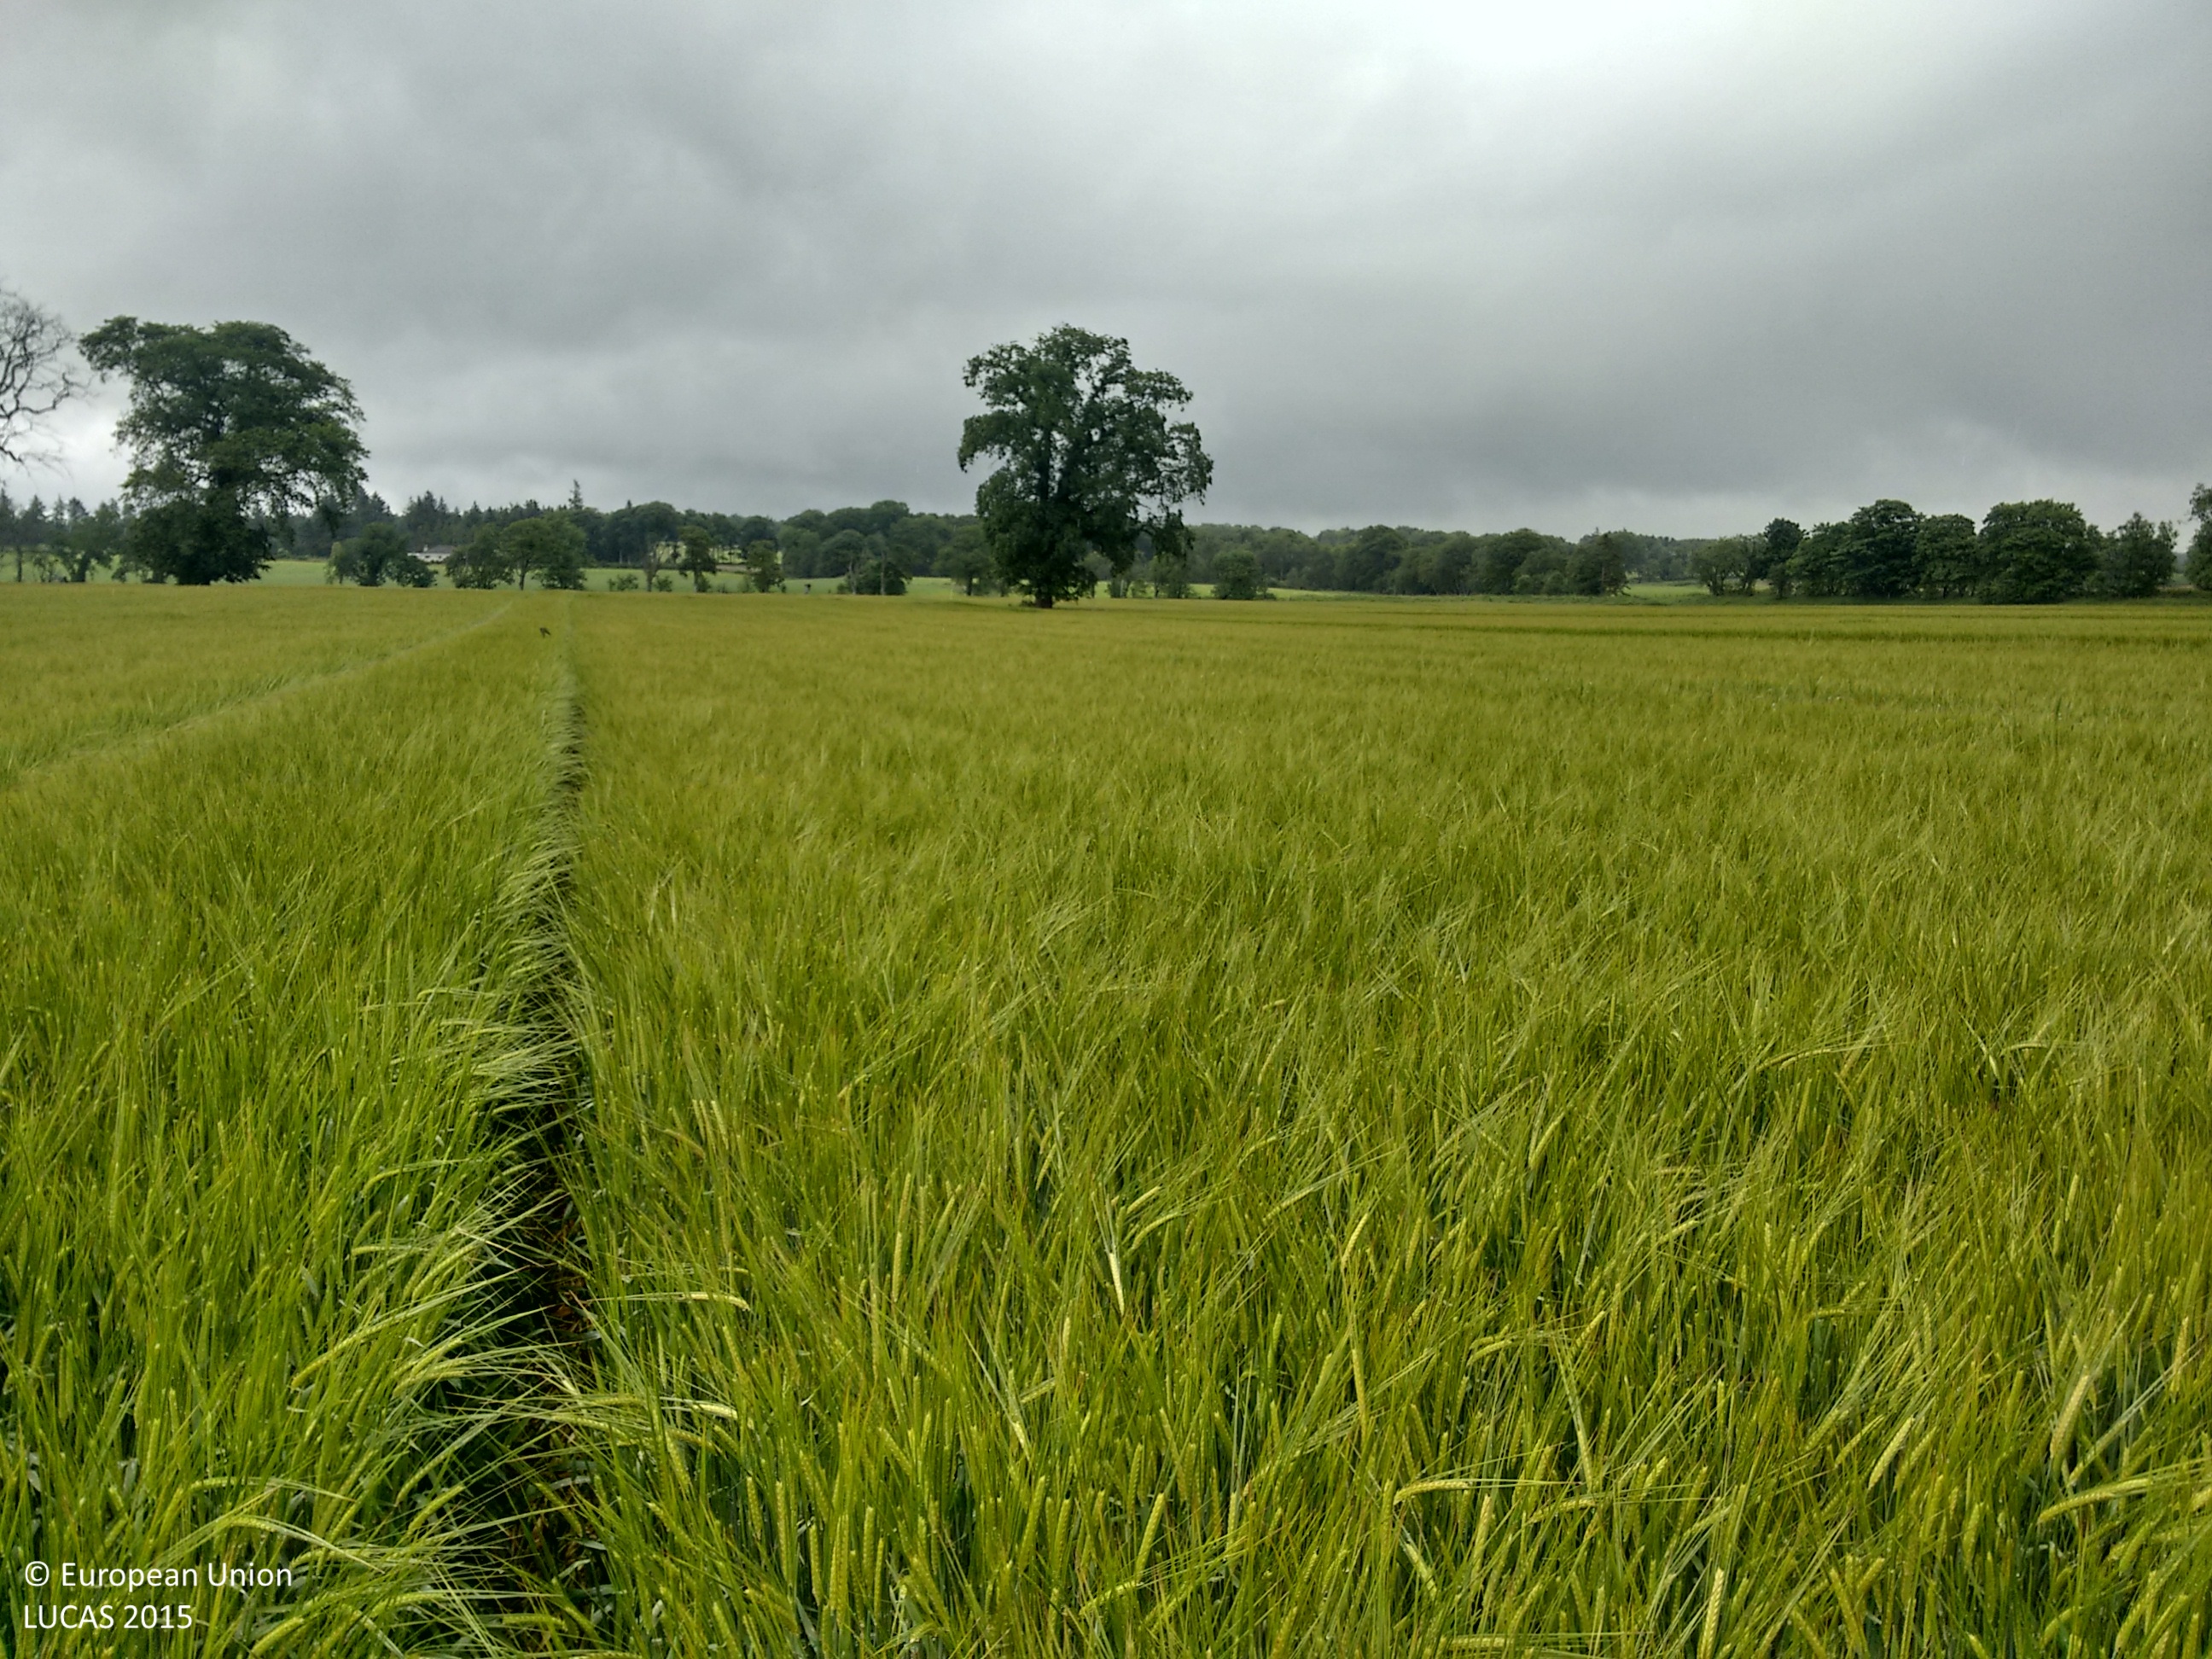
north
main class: Cropland
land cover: Barley
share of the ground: > 75 %
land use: Agriculture (excluding fallow land and kitchen gardens)
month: July
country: GB
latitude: 57.2333
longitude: -2.2934
